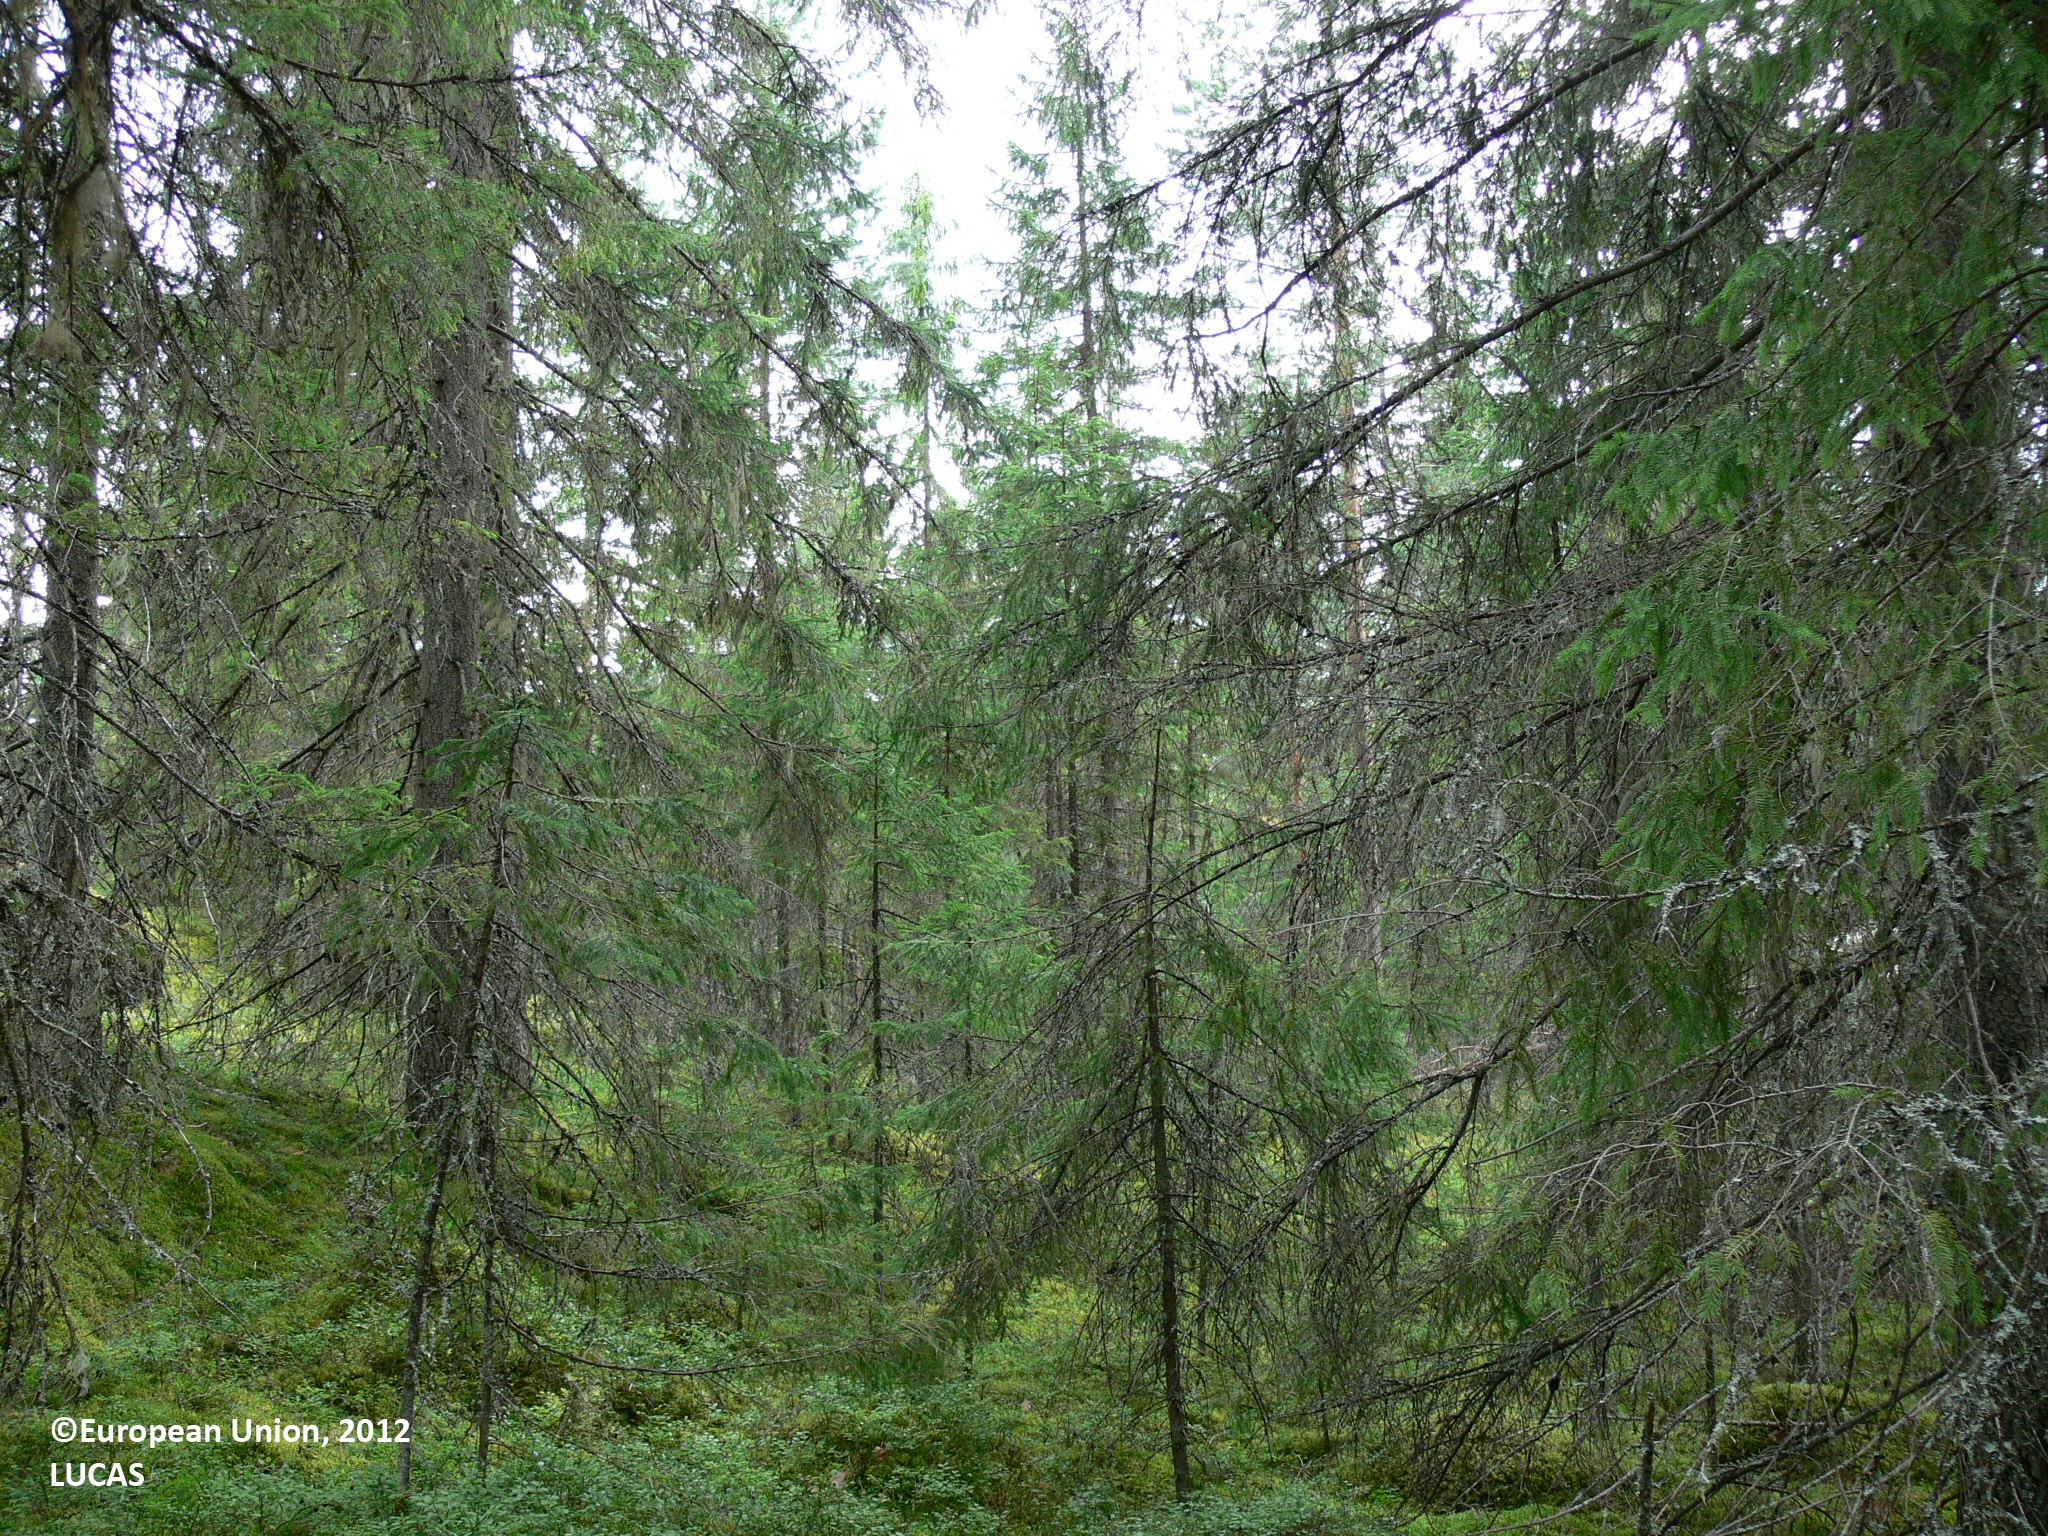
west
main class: Woodland
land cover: Other coniferous woodland
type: boreal forest
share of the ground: > 75 %
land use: Forestry
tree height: > 5 m
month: August
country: FI
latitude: 61.7320
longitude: 29.1821
